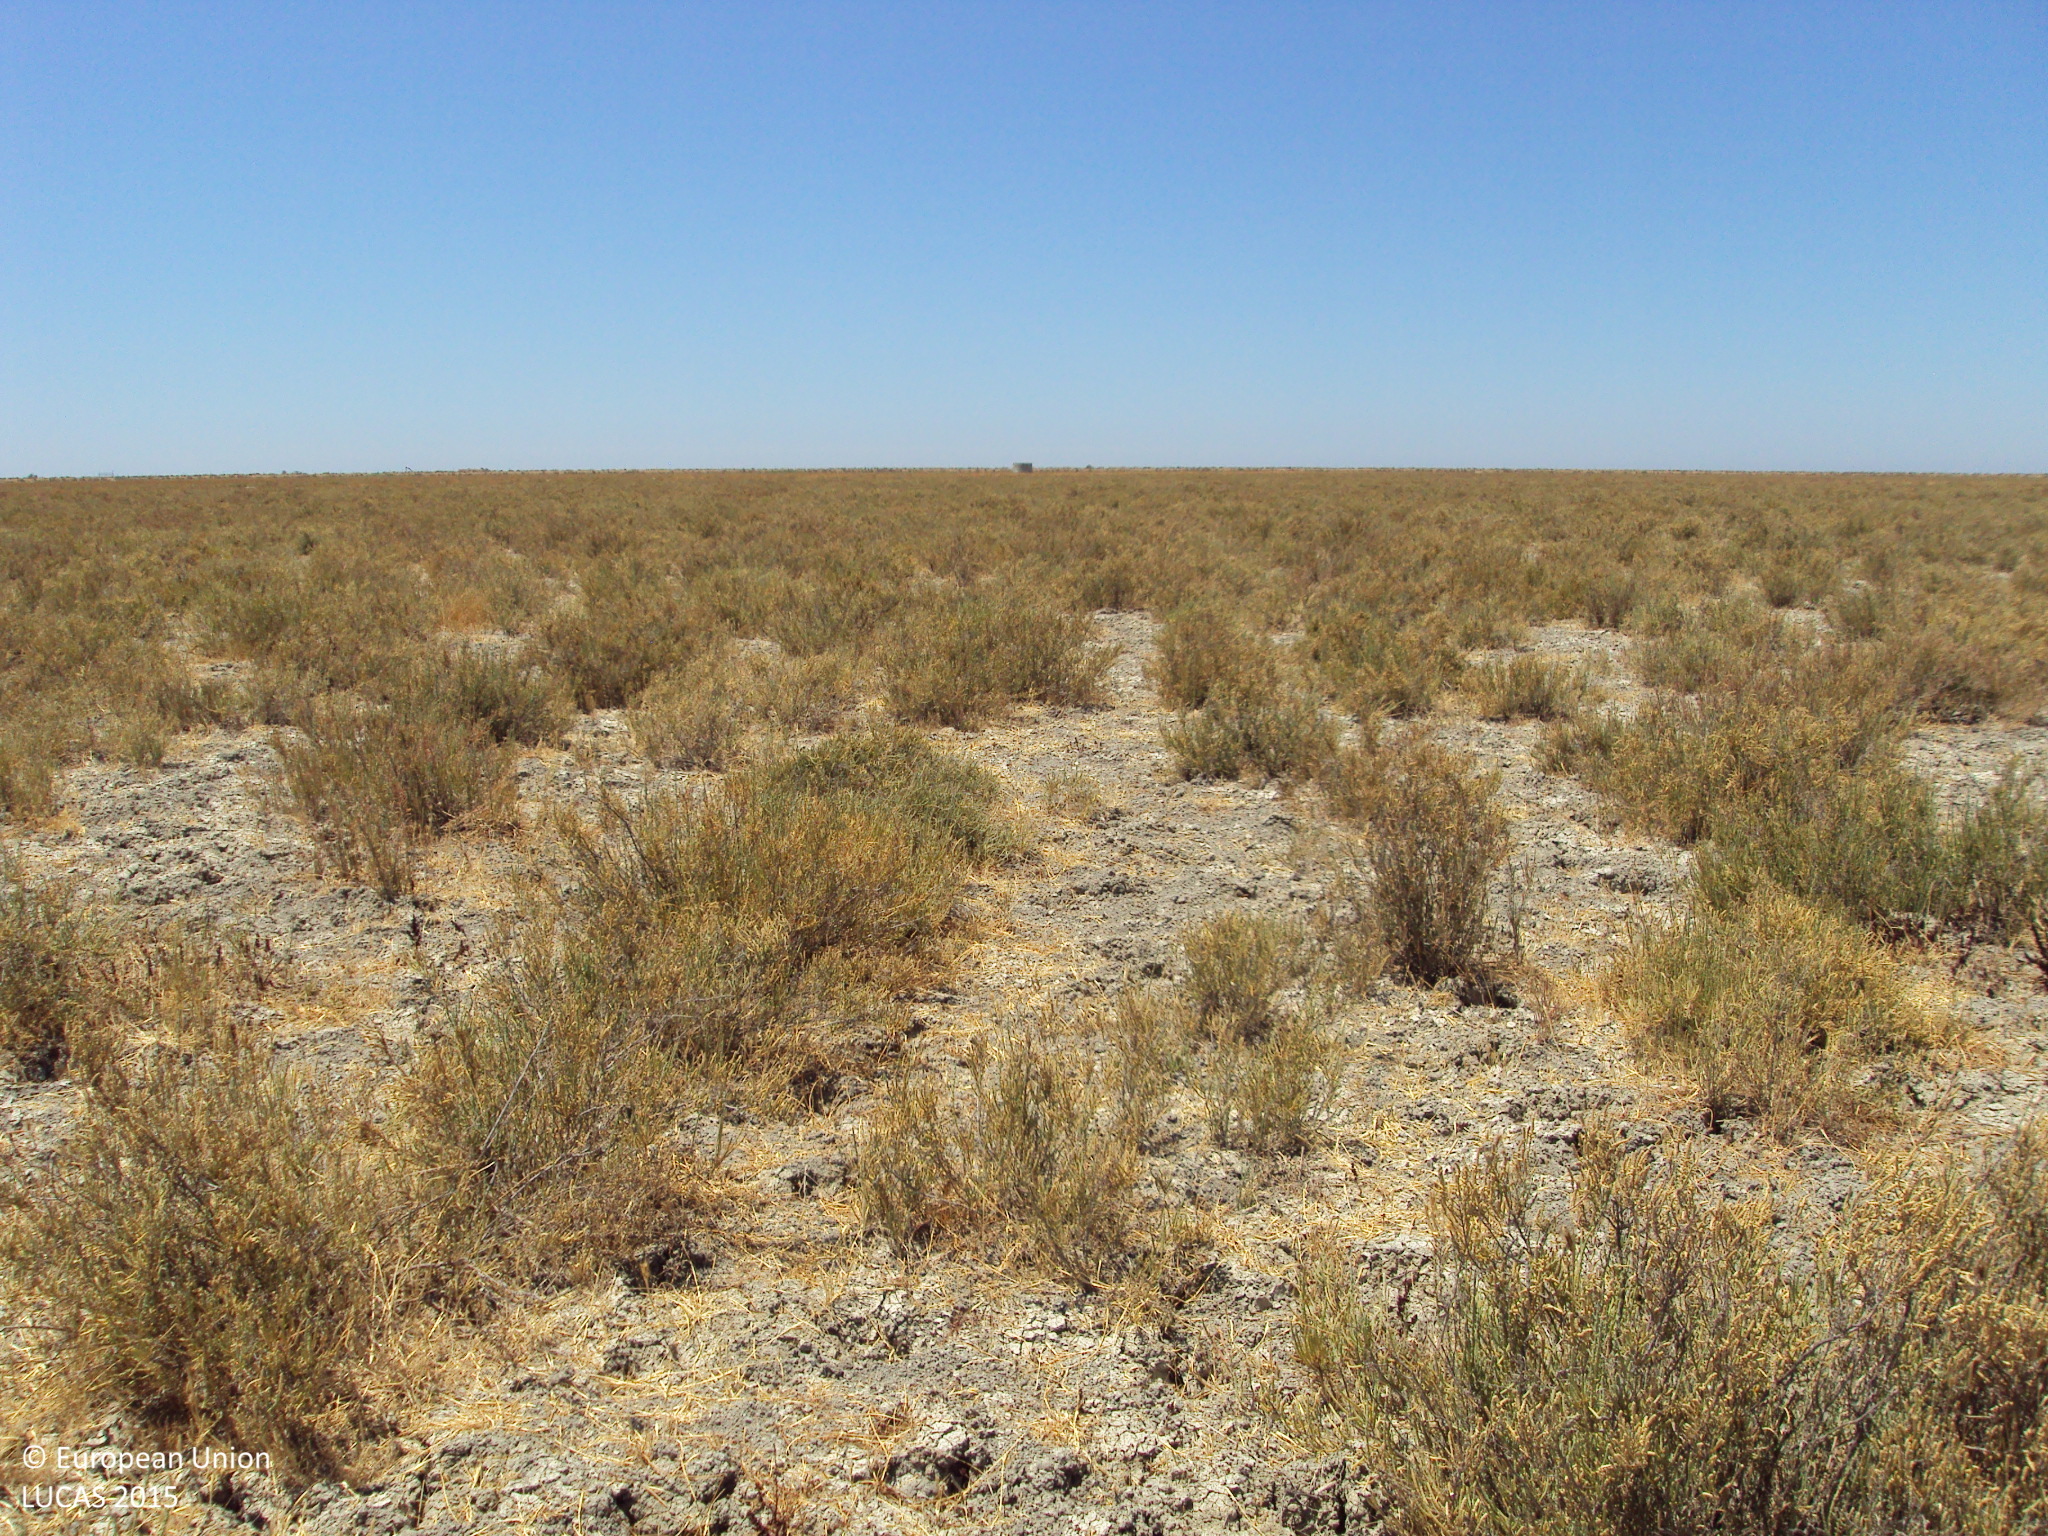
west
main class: Shrubland
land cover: Shrubland without tree cover
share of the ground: 50 - 75 %
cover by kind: shrubs 60 %, herbaceous plants 20 %, unconsolidated bare surface 20 %
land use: Agriculture (excluding fallow land and kitchen gardens)
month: July
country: ES
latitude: 36.9632
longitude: -6.2722
